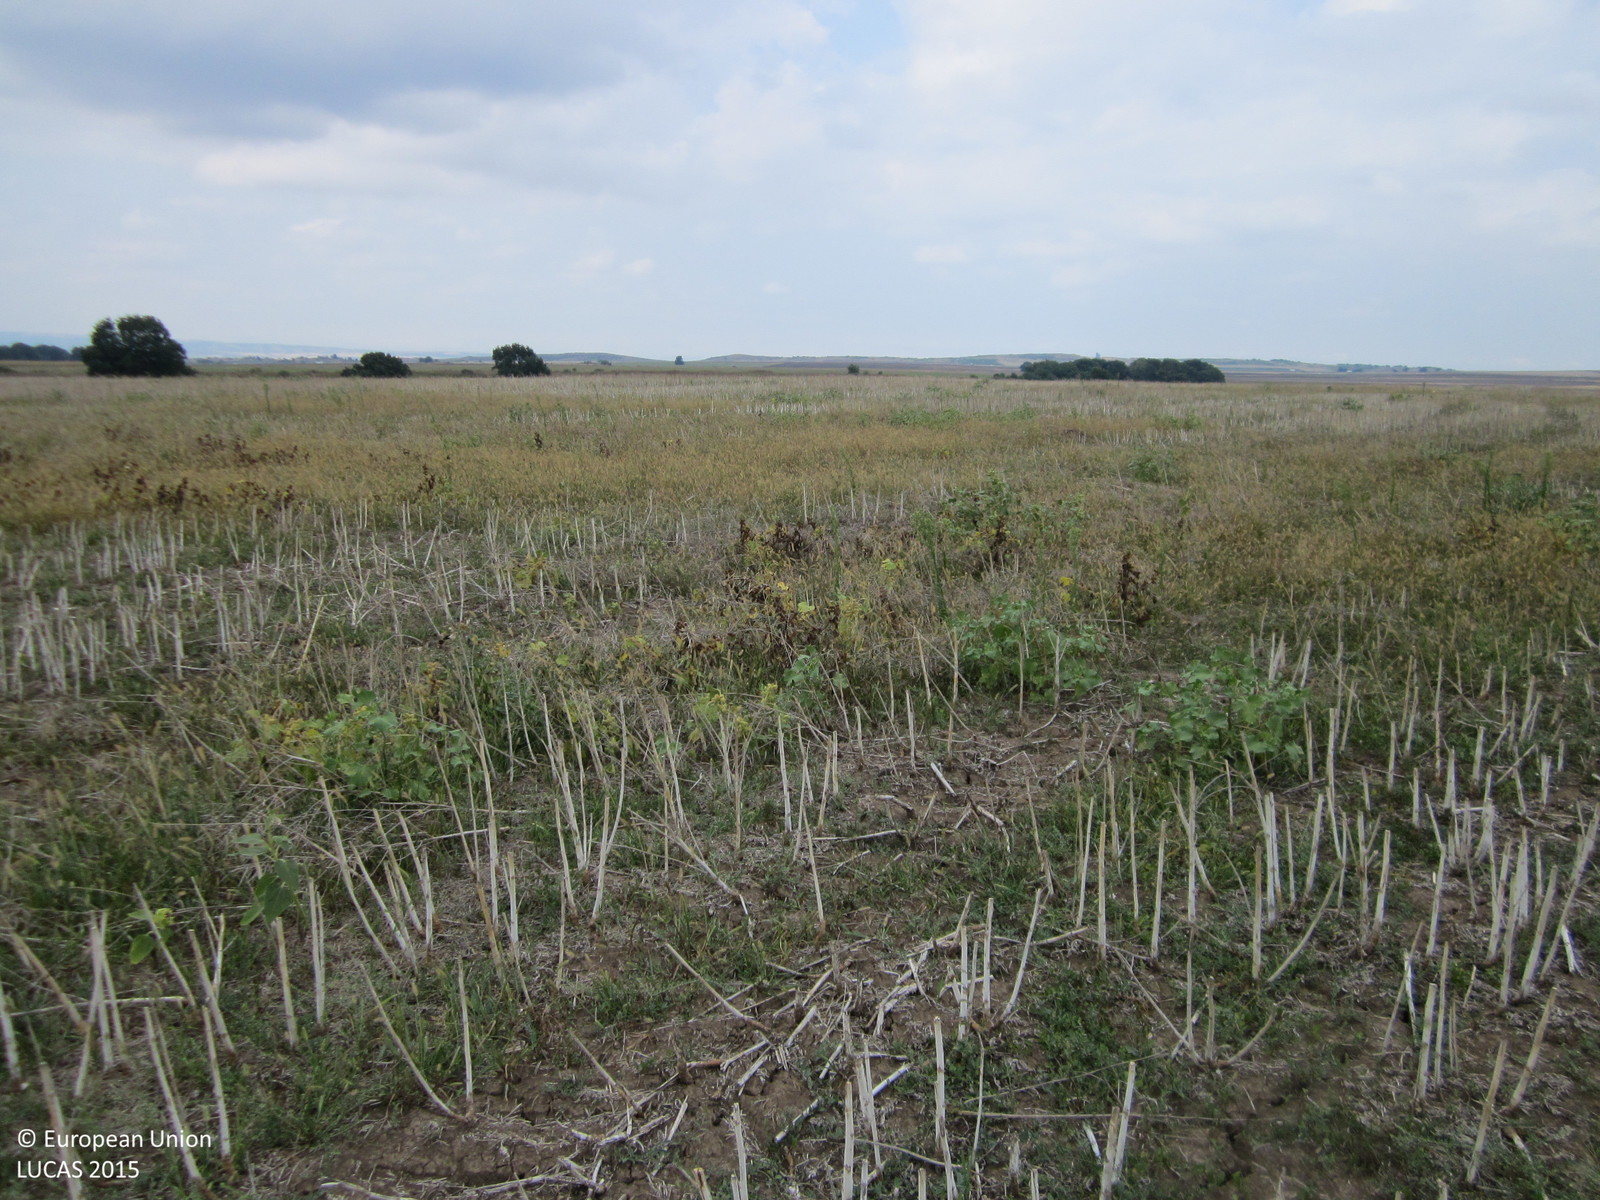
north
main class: Cropland
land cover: Sunflower
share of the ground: 25 - 50 %
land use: Agriculture (excluding fallow land and kitchen gardens)
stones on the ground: < 10 %
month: August
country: BG
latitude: 42.5384
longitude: 26.8432
